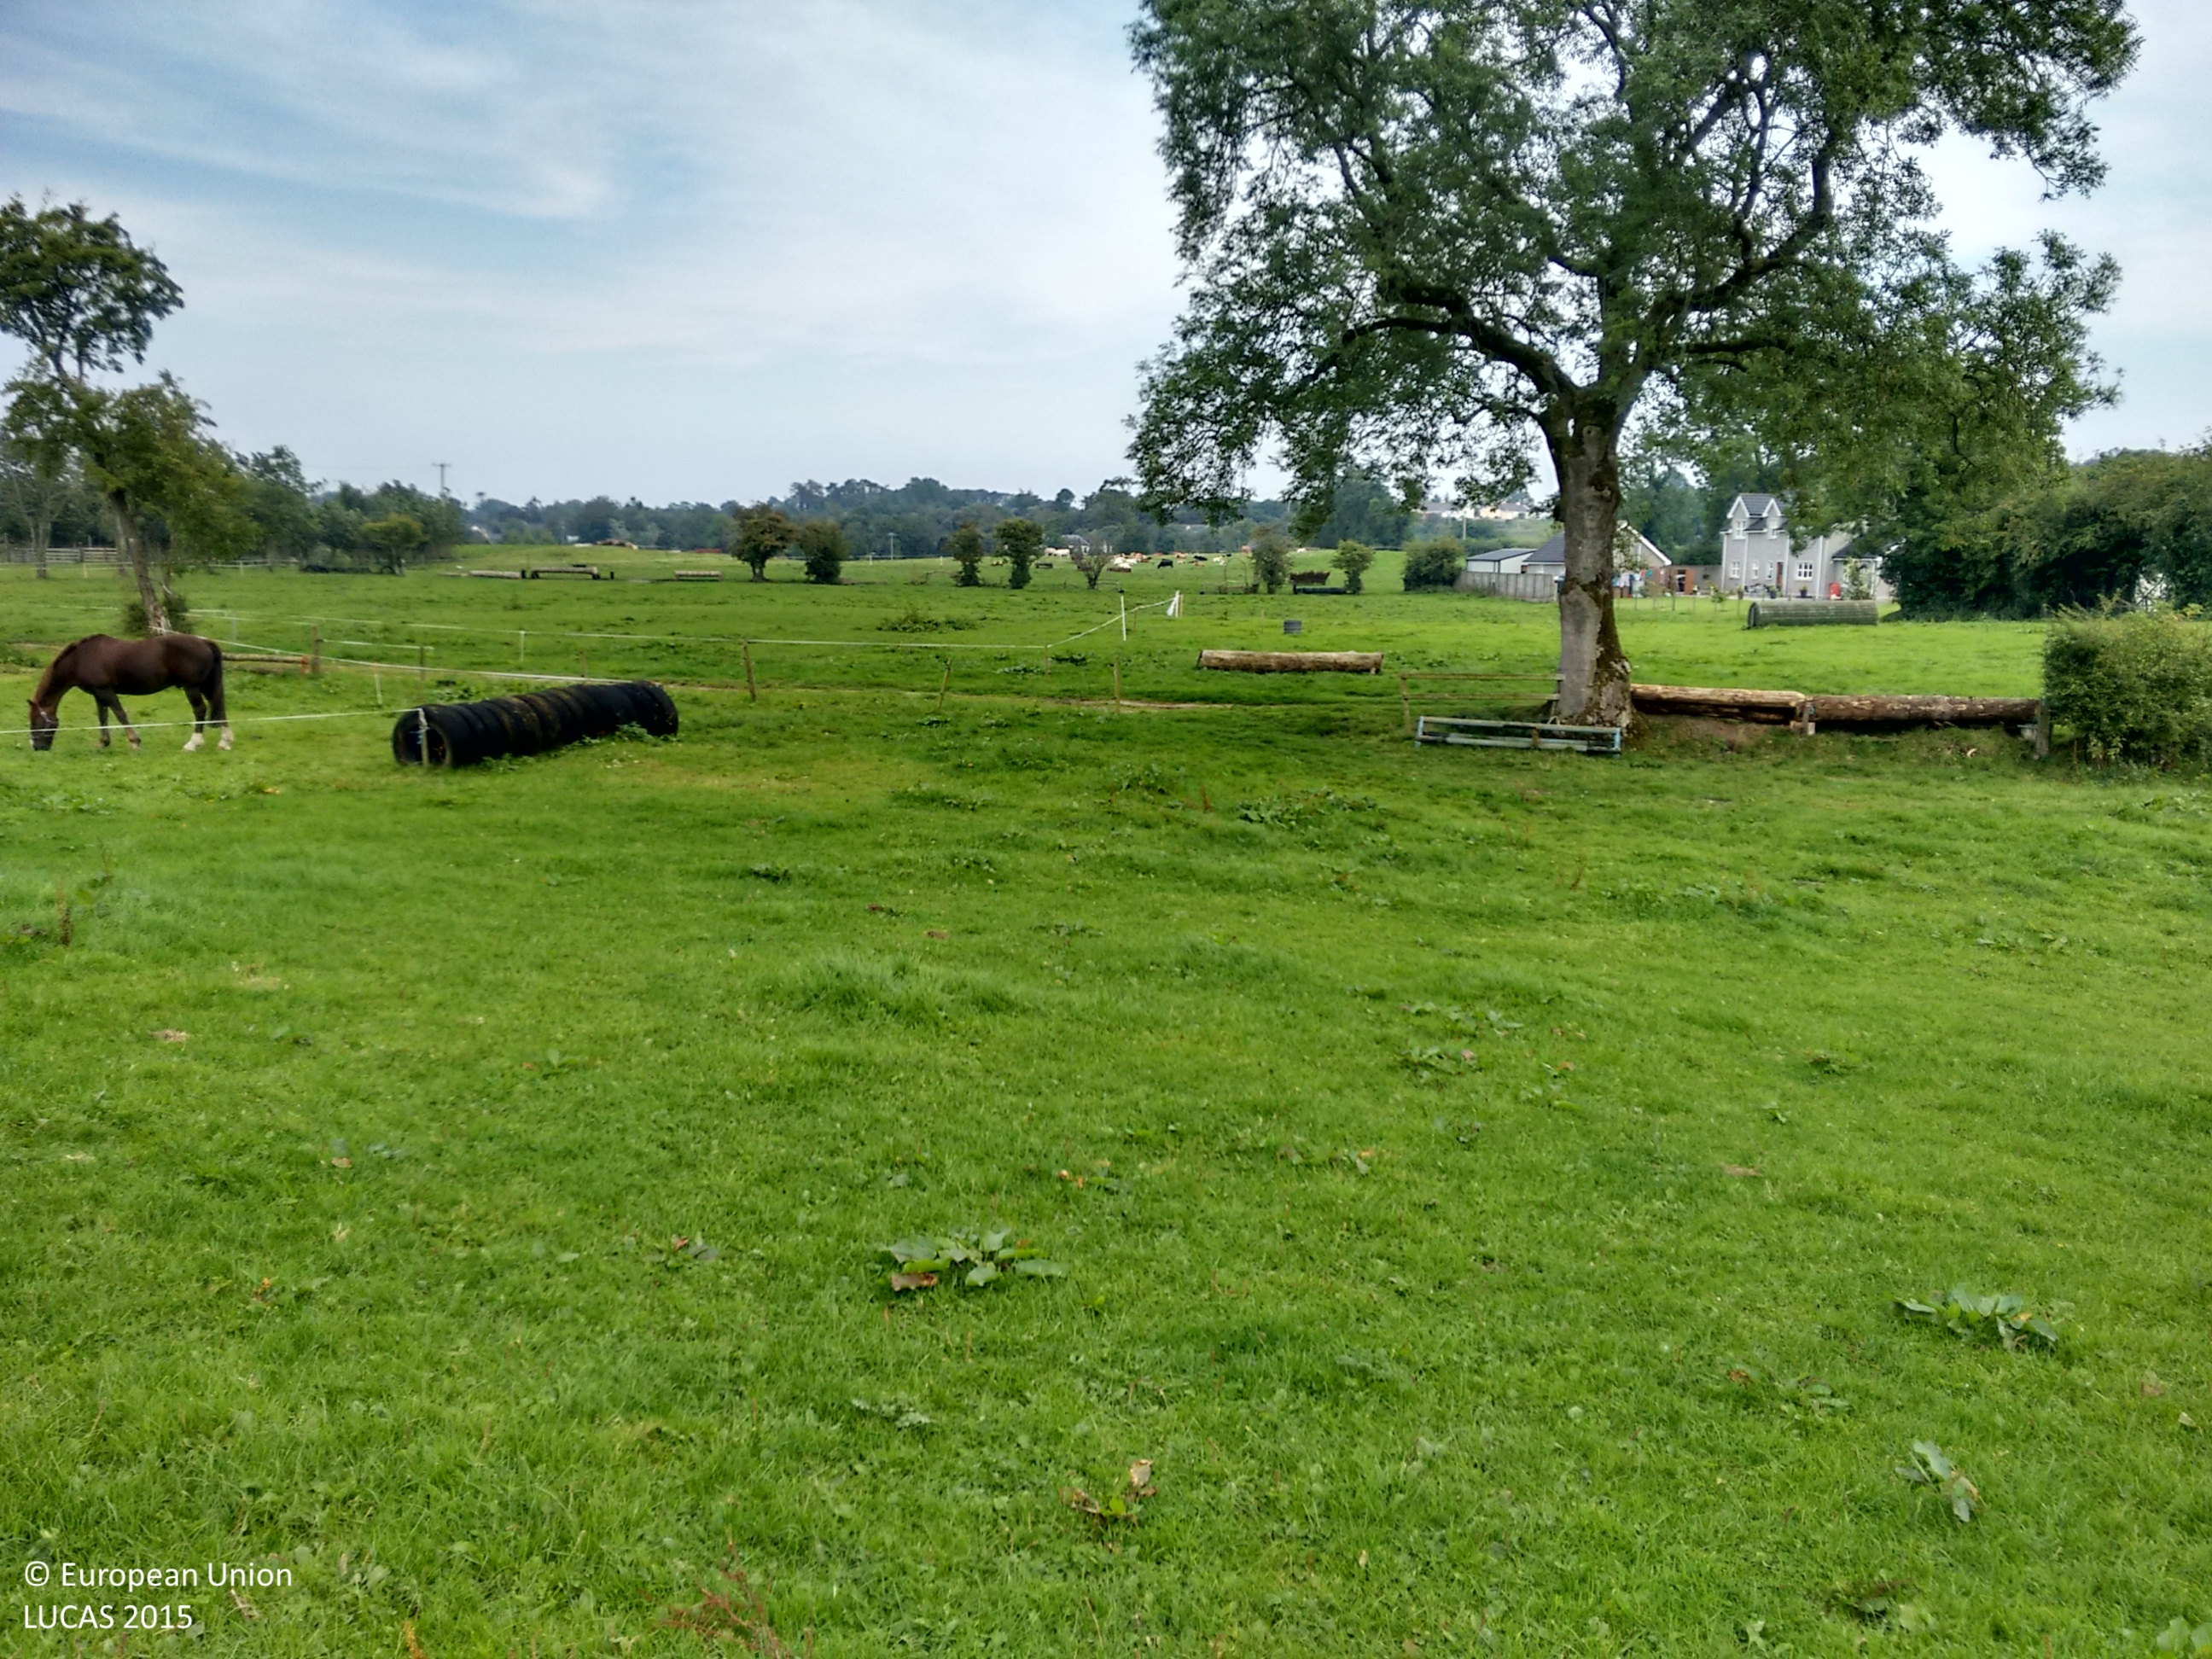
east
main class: Grassland
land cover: Grassland without tree/shrub cover
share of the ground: > 75 %
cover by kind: herbaceous plants 100 %
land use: Agriculture (excluding fallow land and kitchen gardens)
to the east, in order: Grassland without tree/shrub cover; Fences; Tracks; Grassland without tree/shrub cover; Single bushes/trees; Grassland without tree/shrub cover; Fences; Grassland without tree/shrub cover
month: September
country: IE
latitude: 54.3163
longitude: -6.9086
